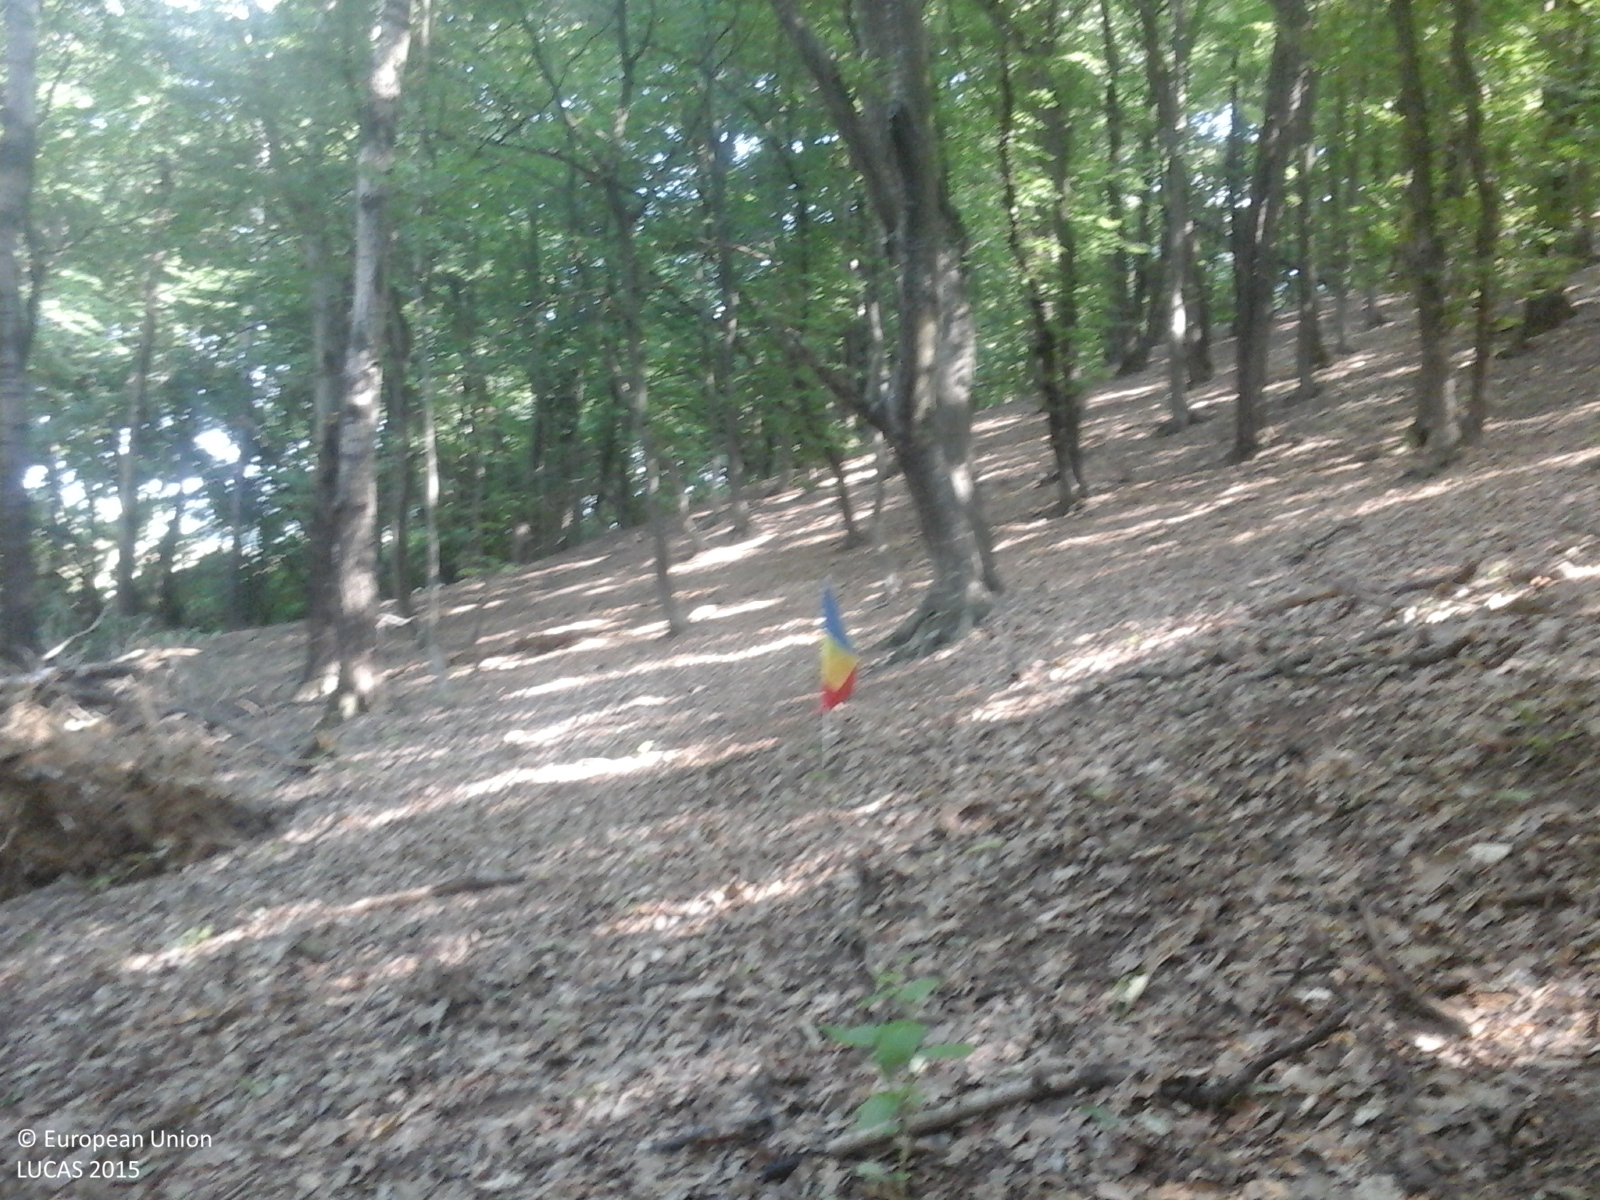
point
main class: Woodland
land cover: Broadleaved woodland
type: beech forest
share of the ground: > 75 %
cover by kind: broadleaved forest trees 100 %
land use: Forestry
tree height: > 5 m
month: June
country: RO
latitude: 47.8249
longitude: 26.4252
